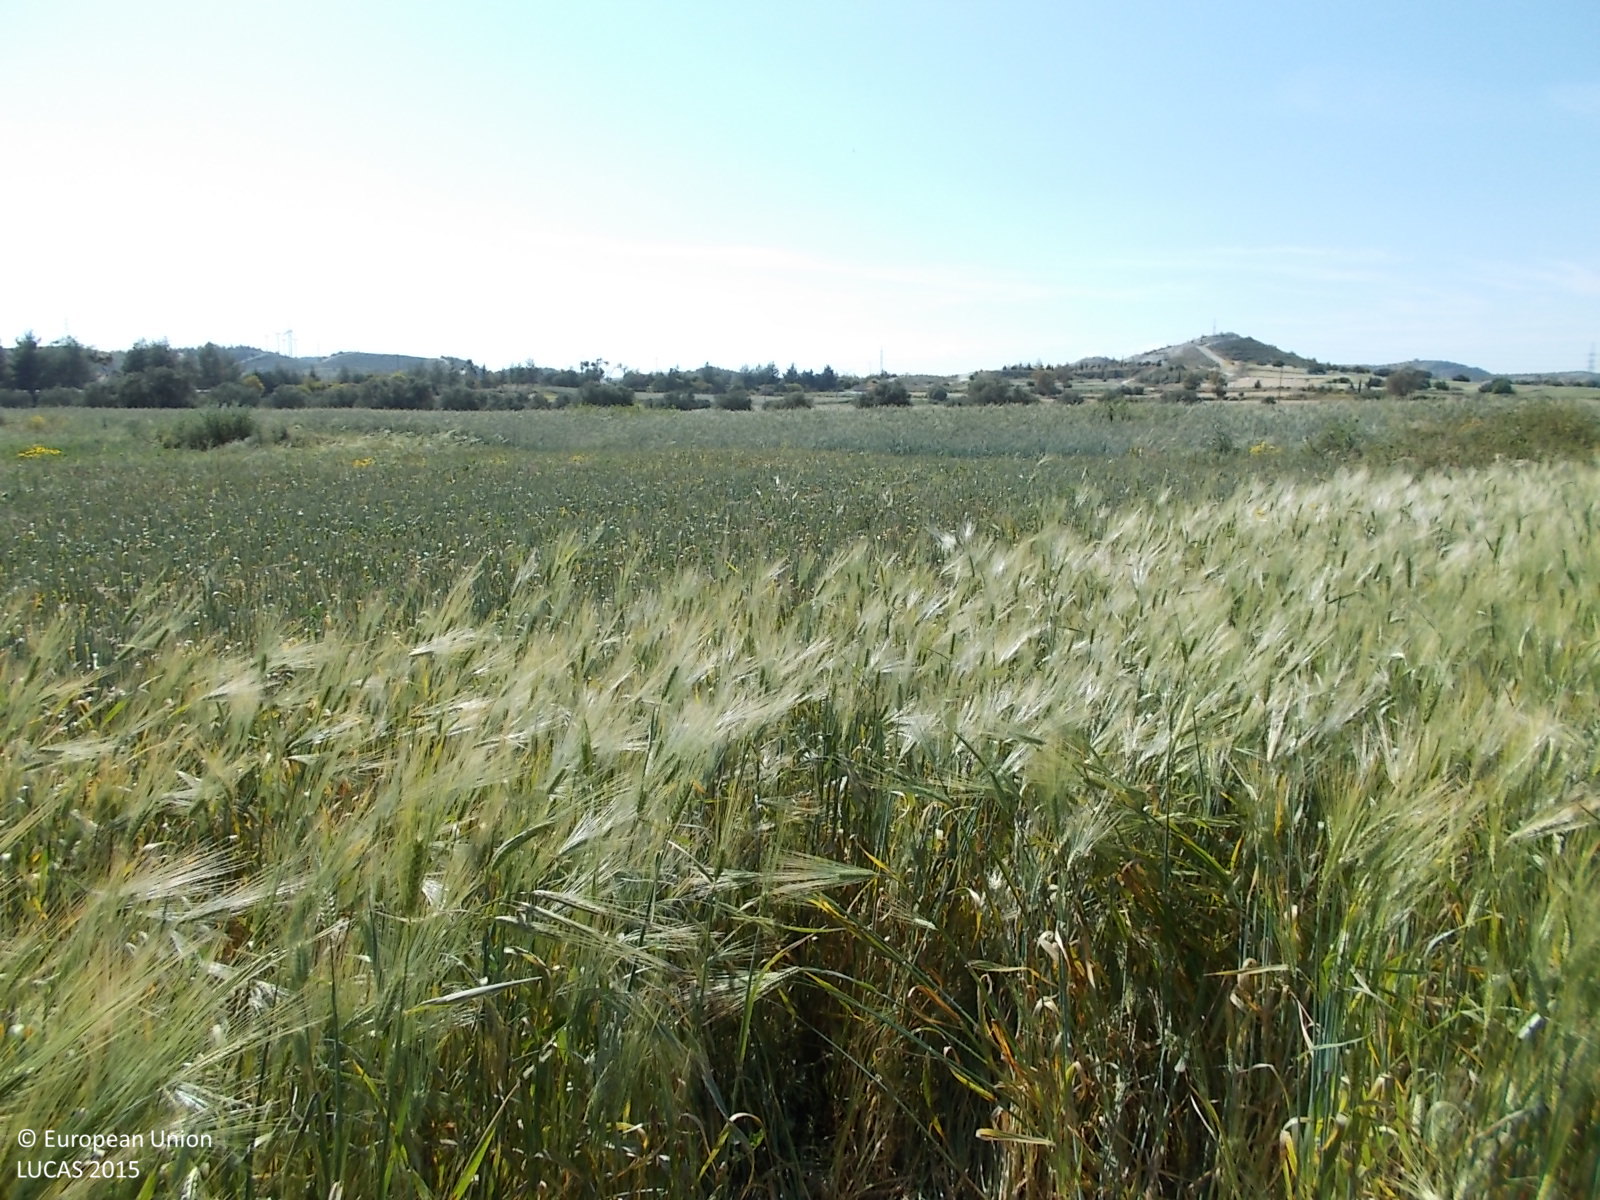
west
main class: Cropland
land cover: Barley
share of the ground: > 75 %
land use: Agriculture (excluding fallow land and kitchen gardens)
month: April
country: CY
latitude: 34.9688
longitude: 33.5571
